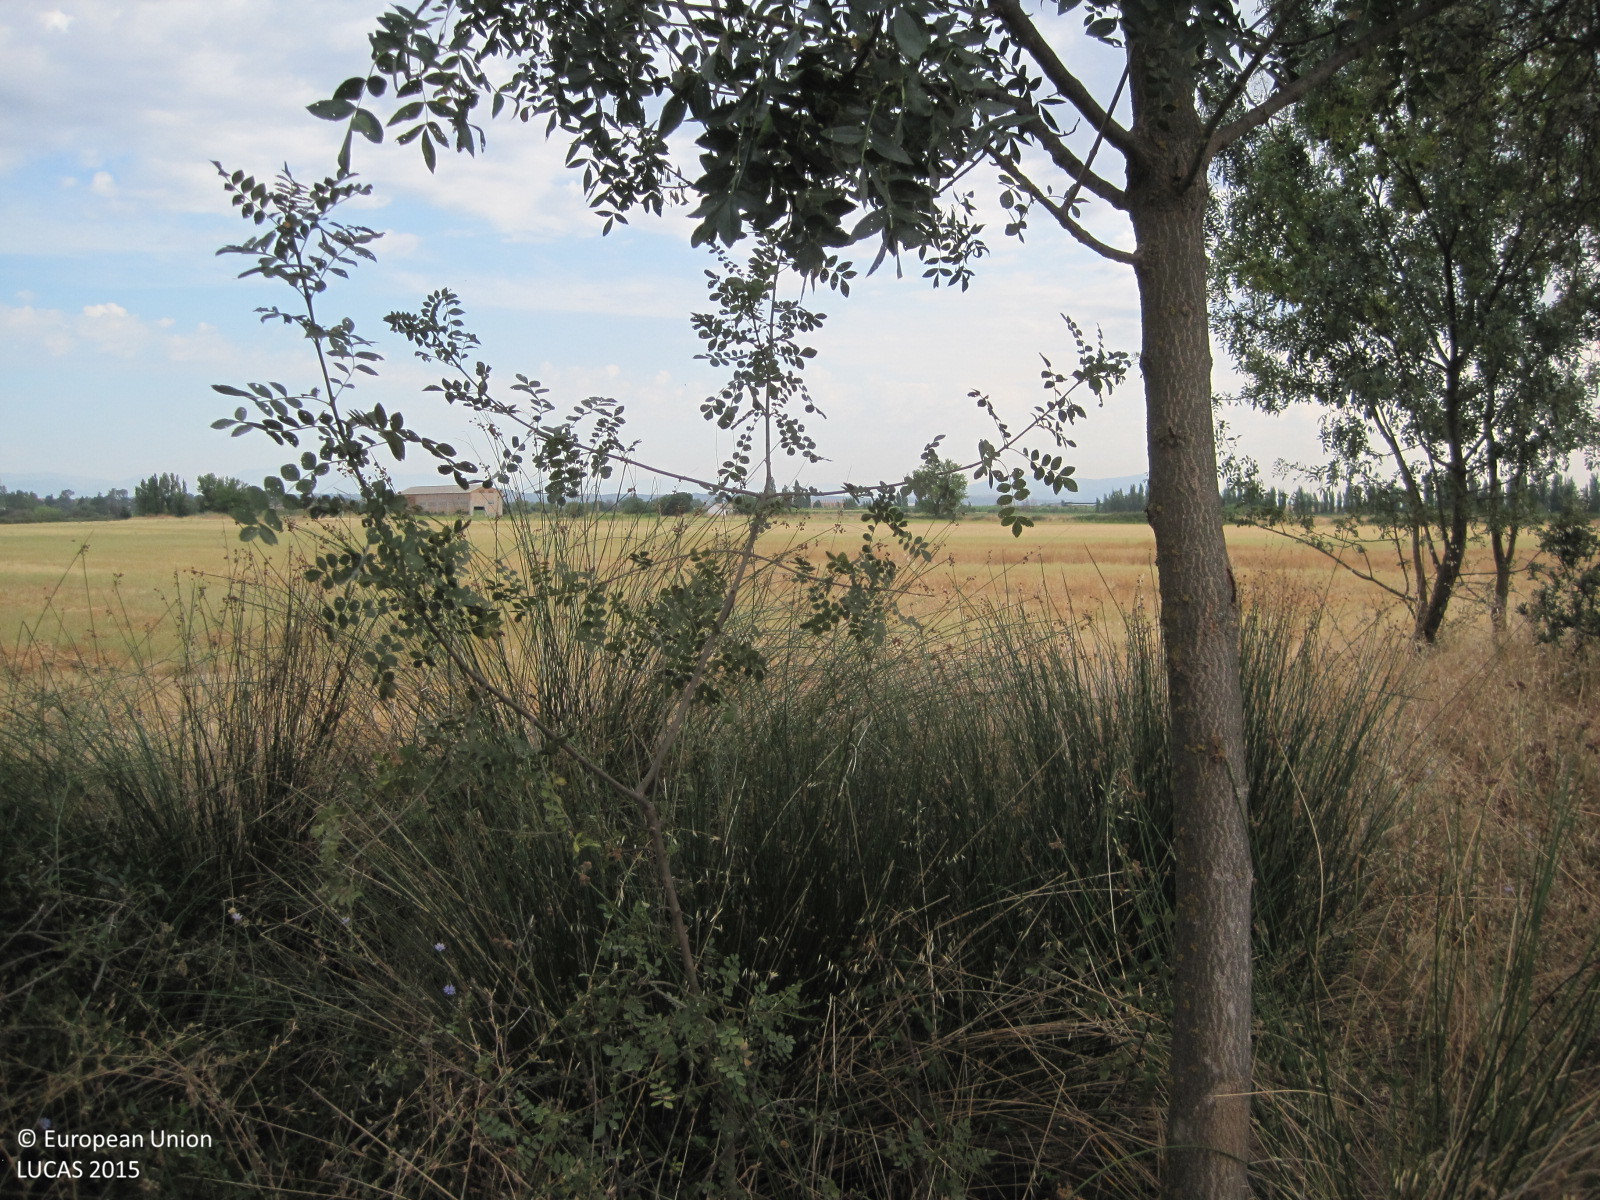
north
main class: Cropland
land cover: Maize
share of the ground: > 75 %
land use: Agriculture (excluding fallow land and kitchen gardens)
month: August
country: ES
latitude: 39.8847
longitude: -4.9581
